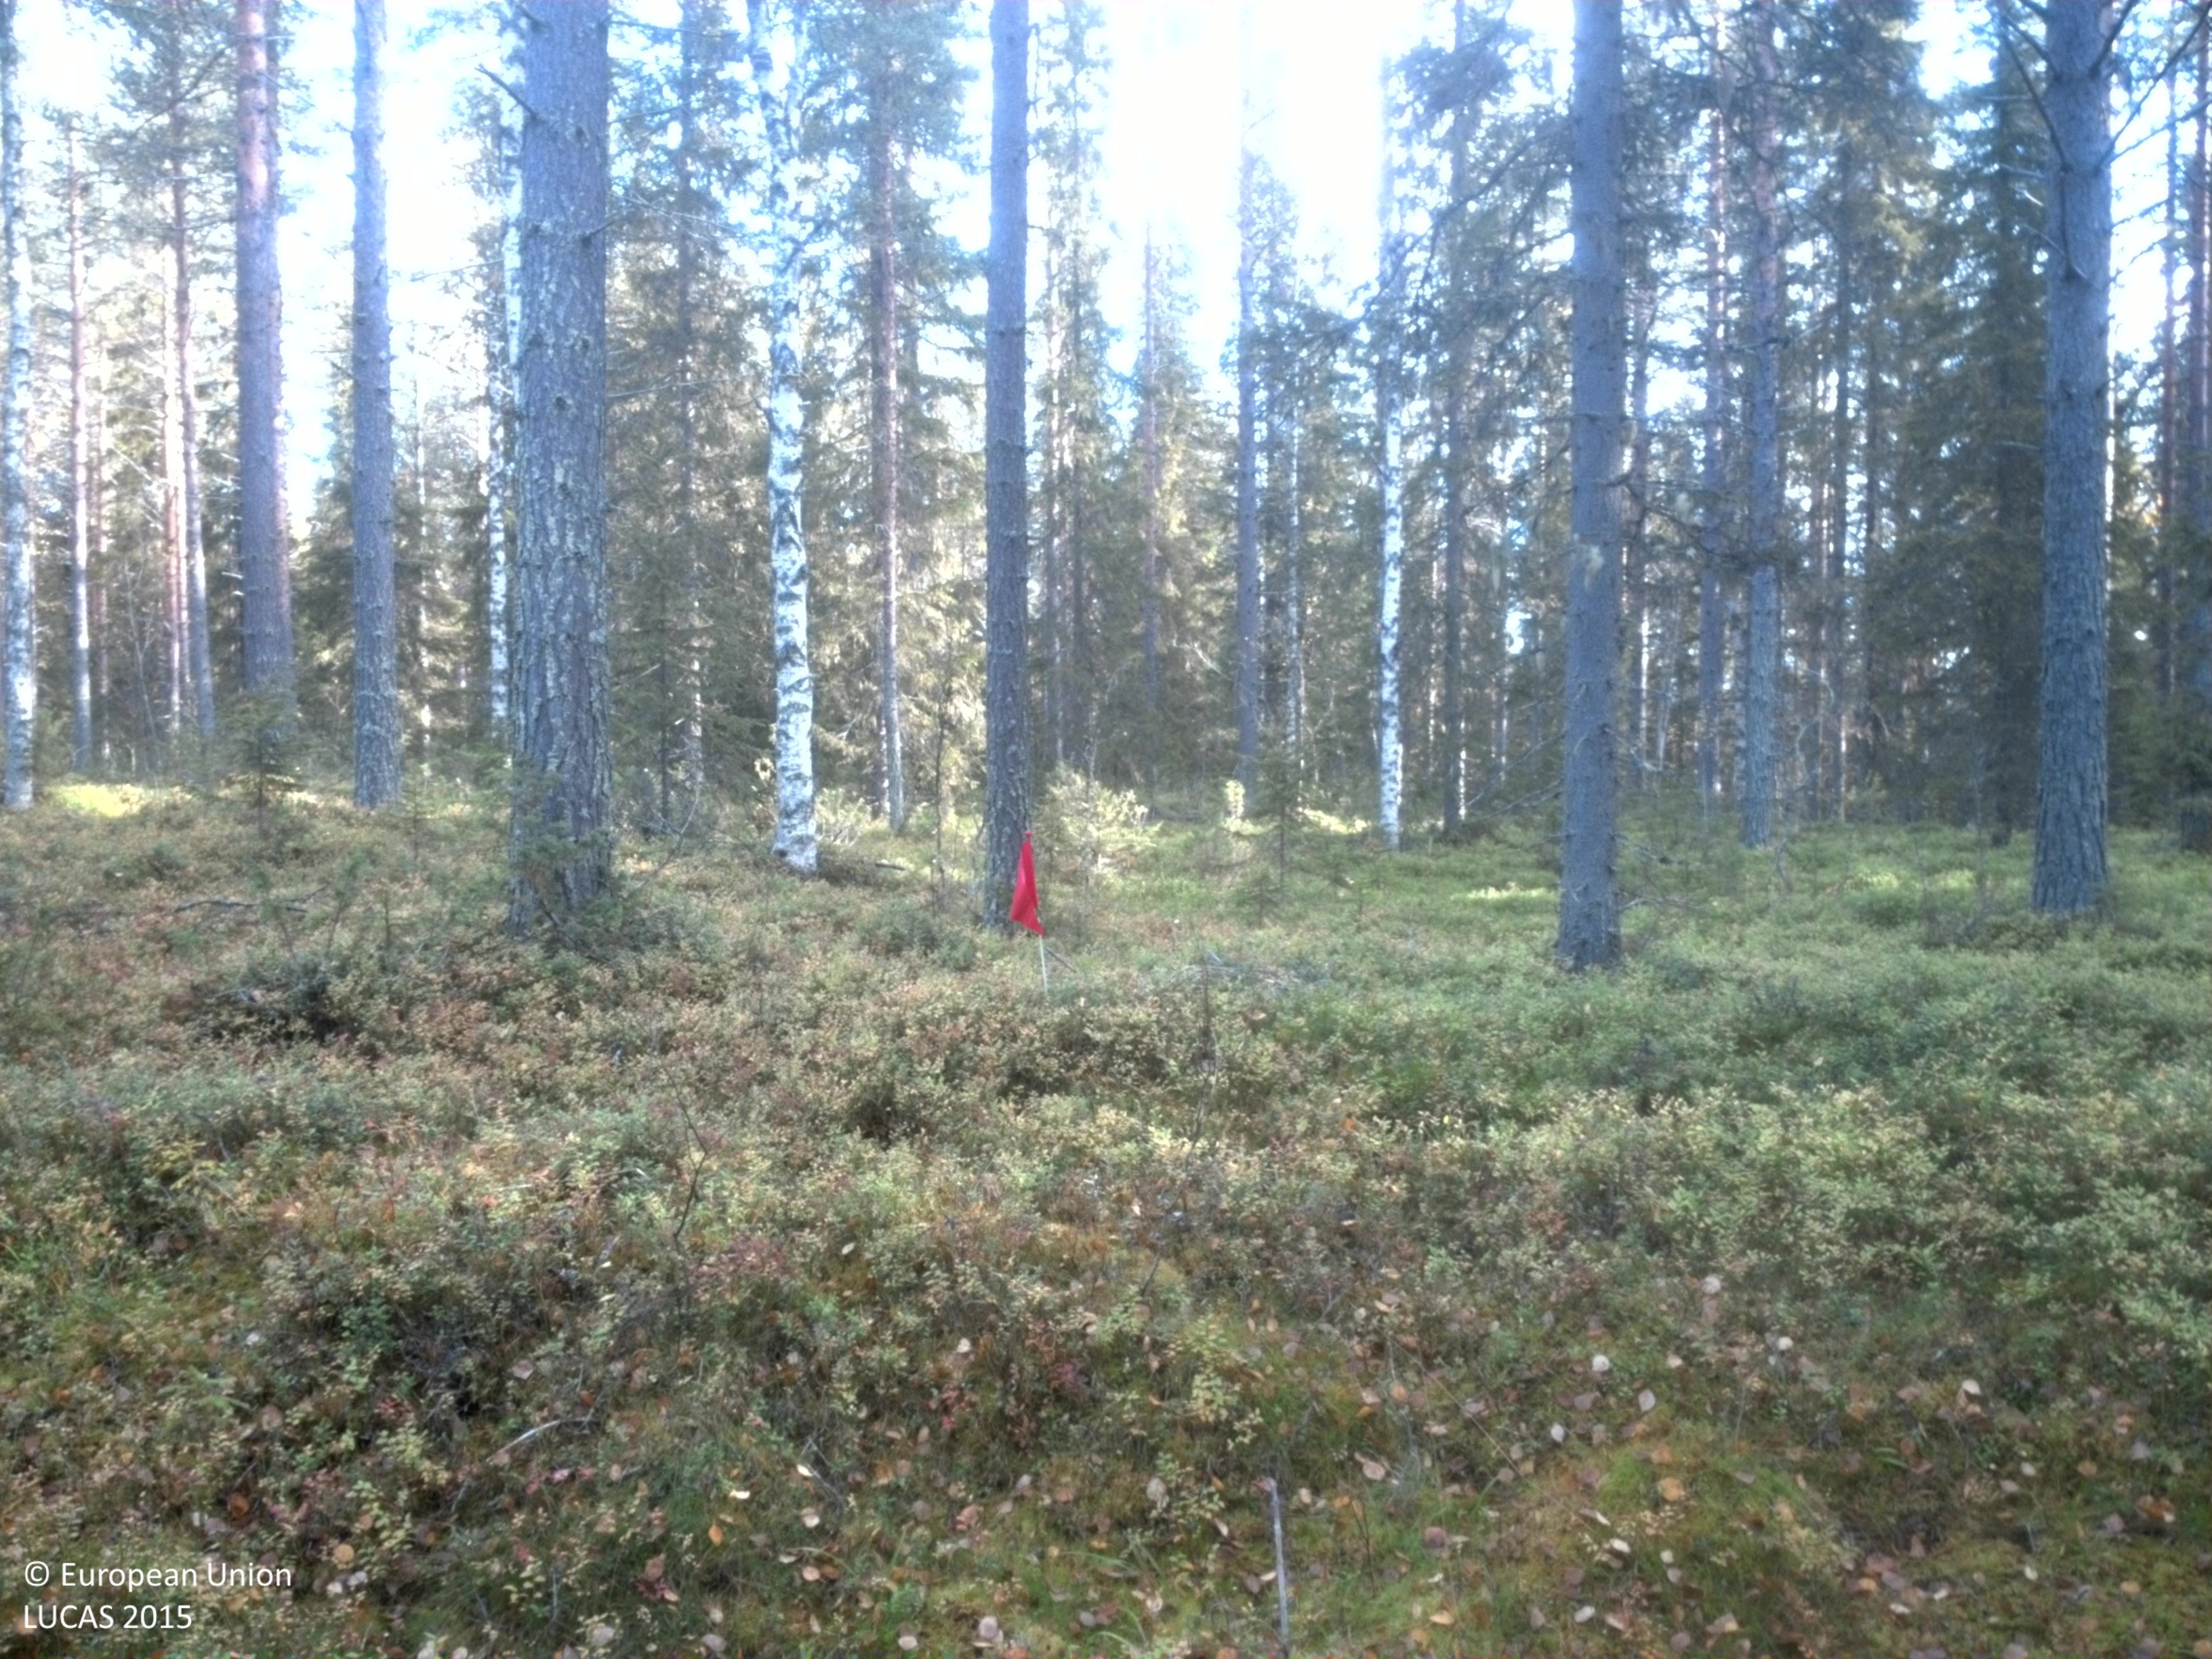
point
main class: Woodland
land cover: Spruce dominated coniferous woodland
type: boreal forest
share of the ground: 50 - 75 %
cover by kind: coniferous forest trees 55 %, shrubs 35 %, broadleaved forest trees 5 %, lichens and mosses 5 %
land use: Forestry
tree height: > 5 m
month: September
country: SE
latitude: 64.2523
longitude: 19.8998
